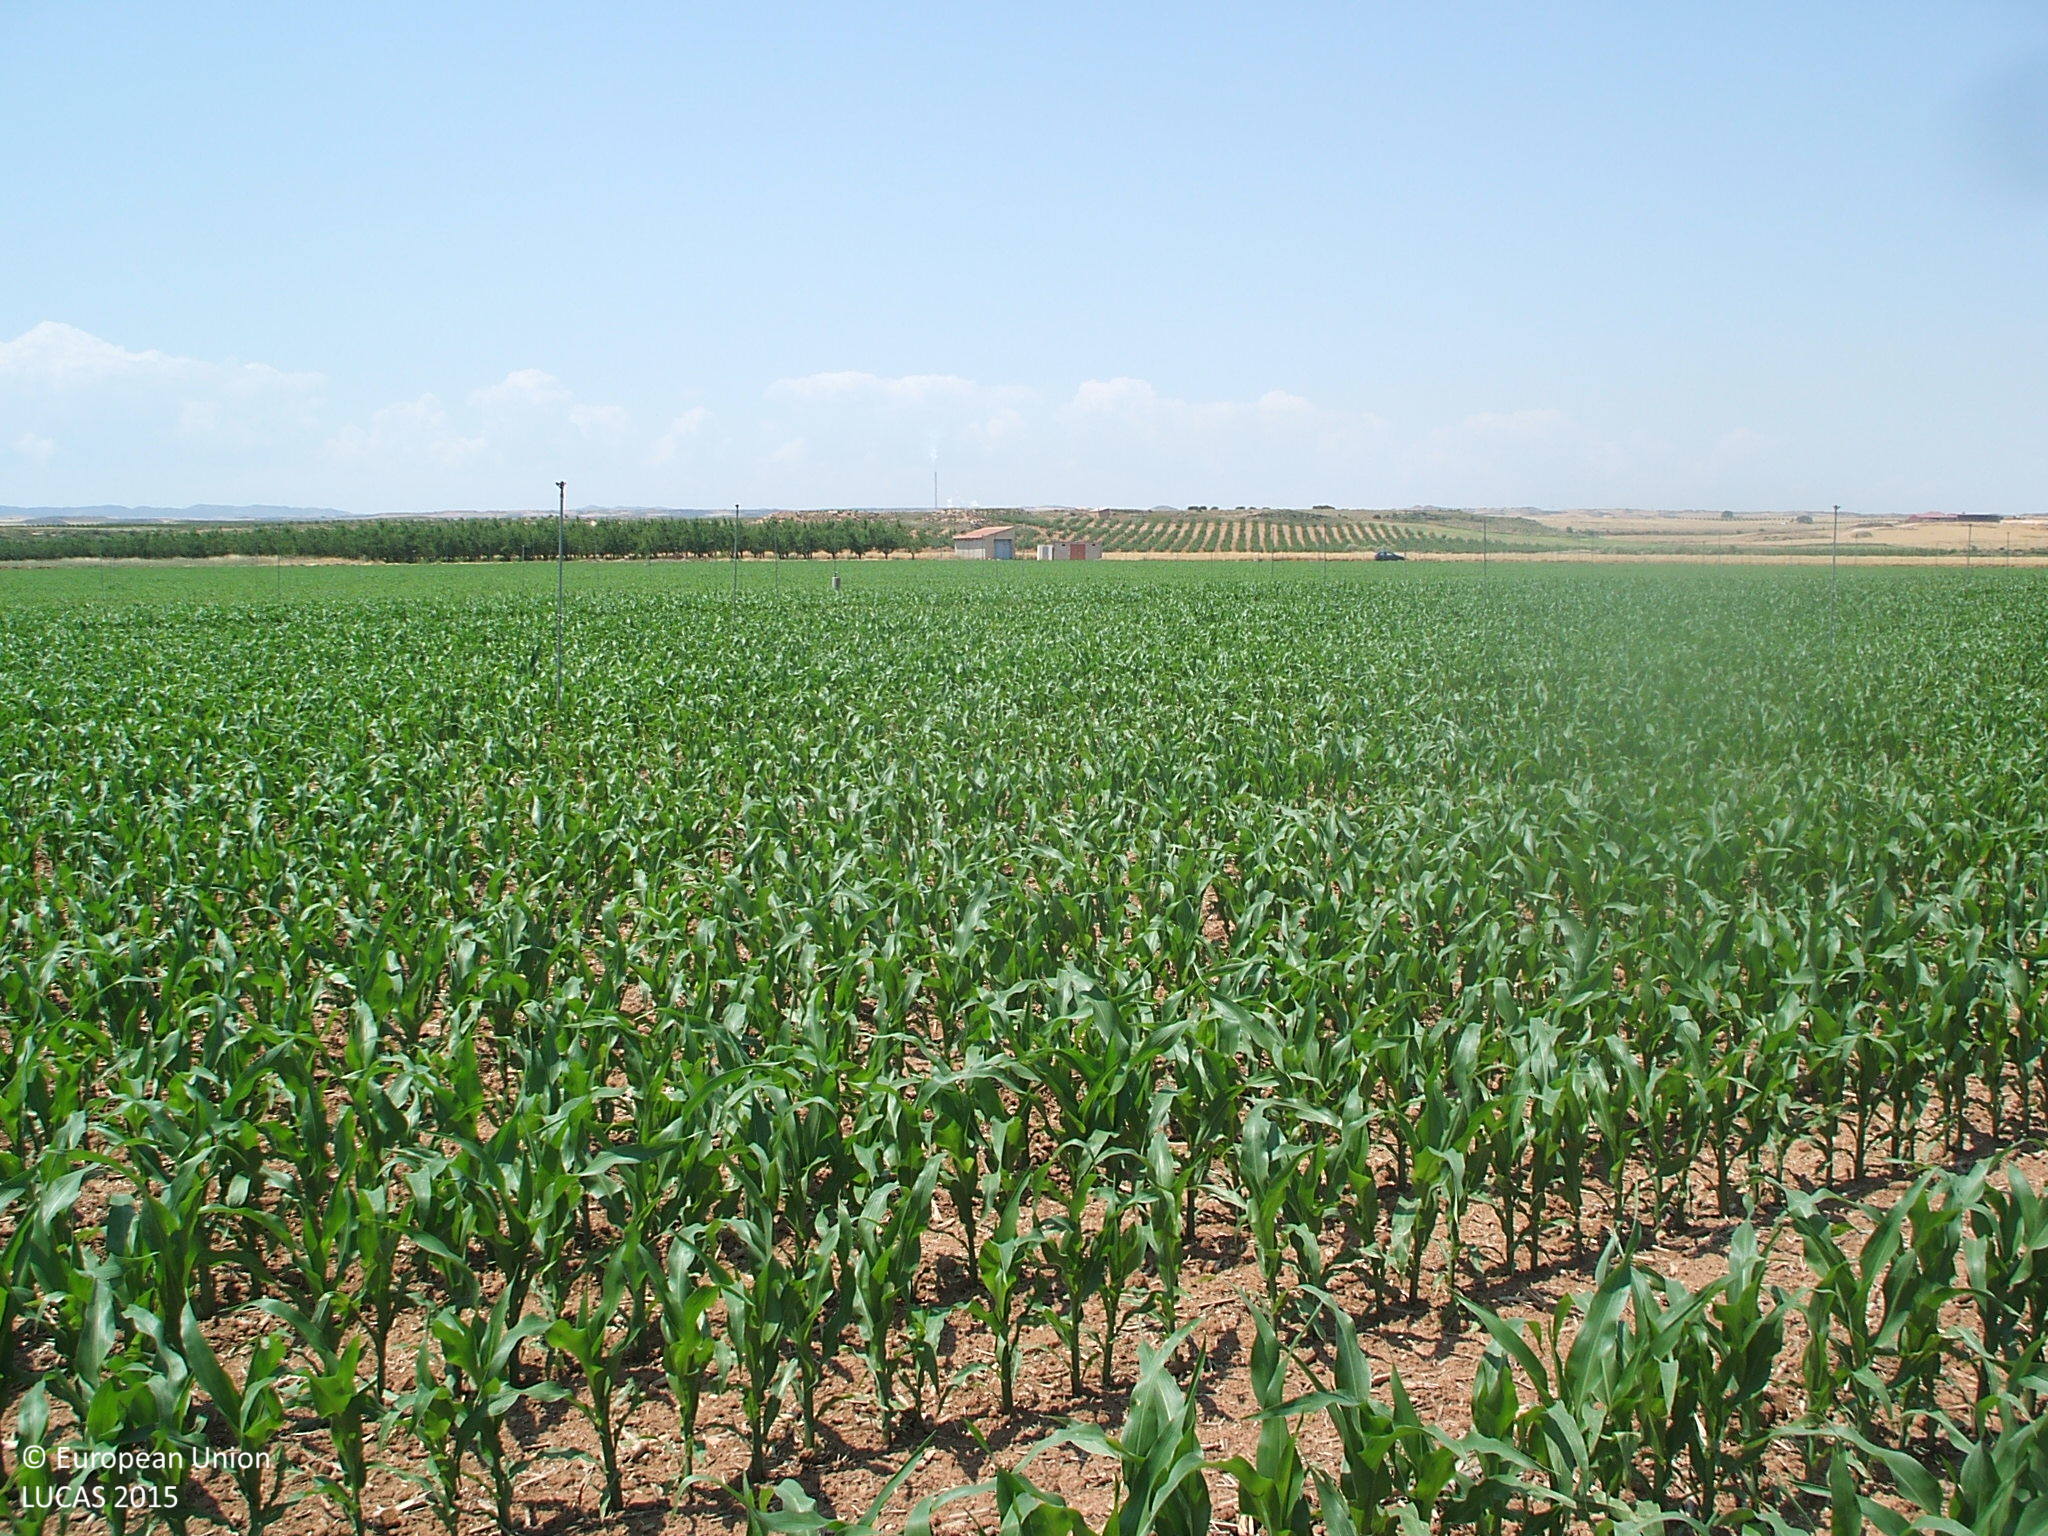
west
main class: Cropland
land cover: Maize
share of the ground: 50 - 75 %
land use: Agriculture (excluding fallow land and kitchen gardens)
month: June
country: ES
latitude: 41.0273
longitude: -0.2042
